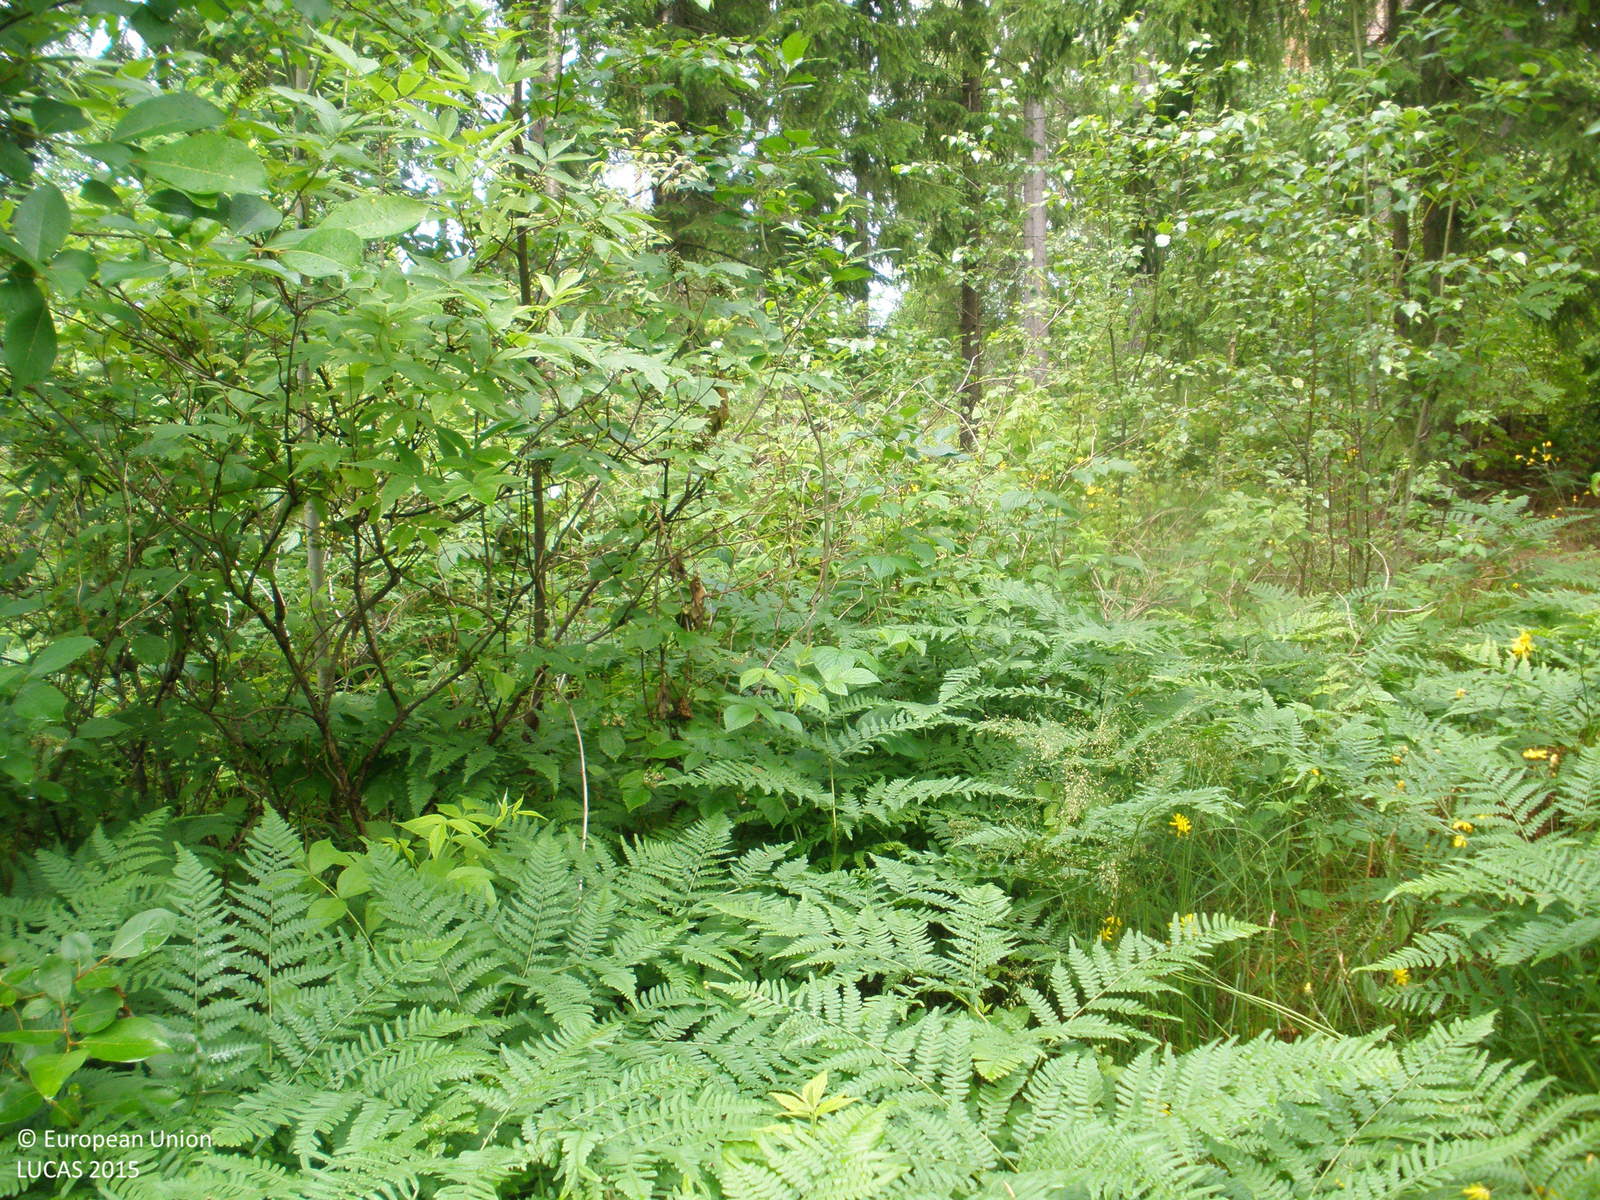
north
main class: Shrubland
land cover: Shrubland with sparse tree cover
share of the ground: > 75 %
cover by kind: shrubs 85 %, broadleaved forest trees 5 %, herbaceous plants 5 %, lichens and mosses 5 %
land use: Forestry
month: July
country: FI
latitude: 61.2442
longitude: 23.7445
